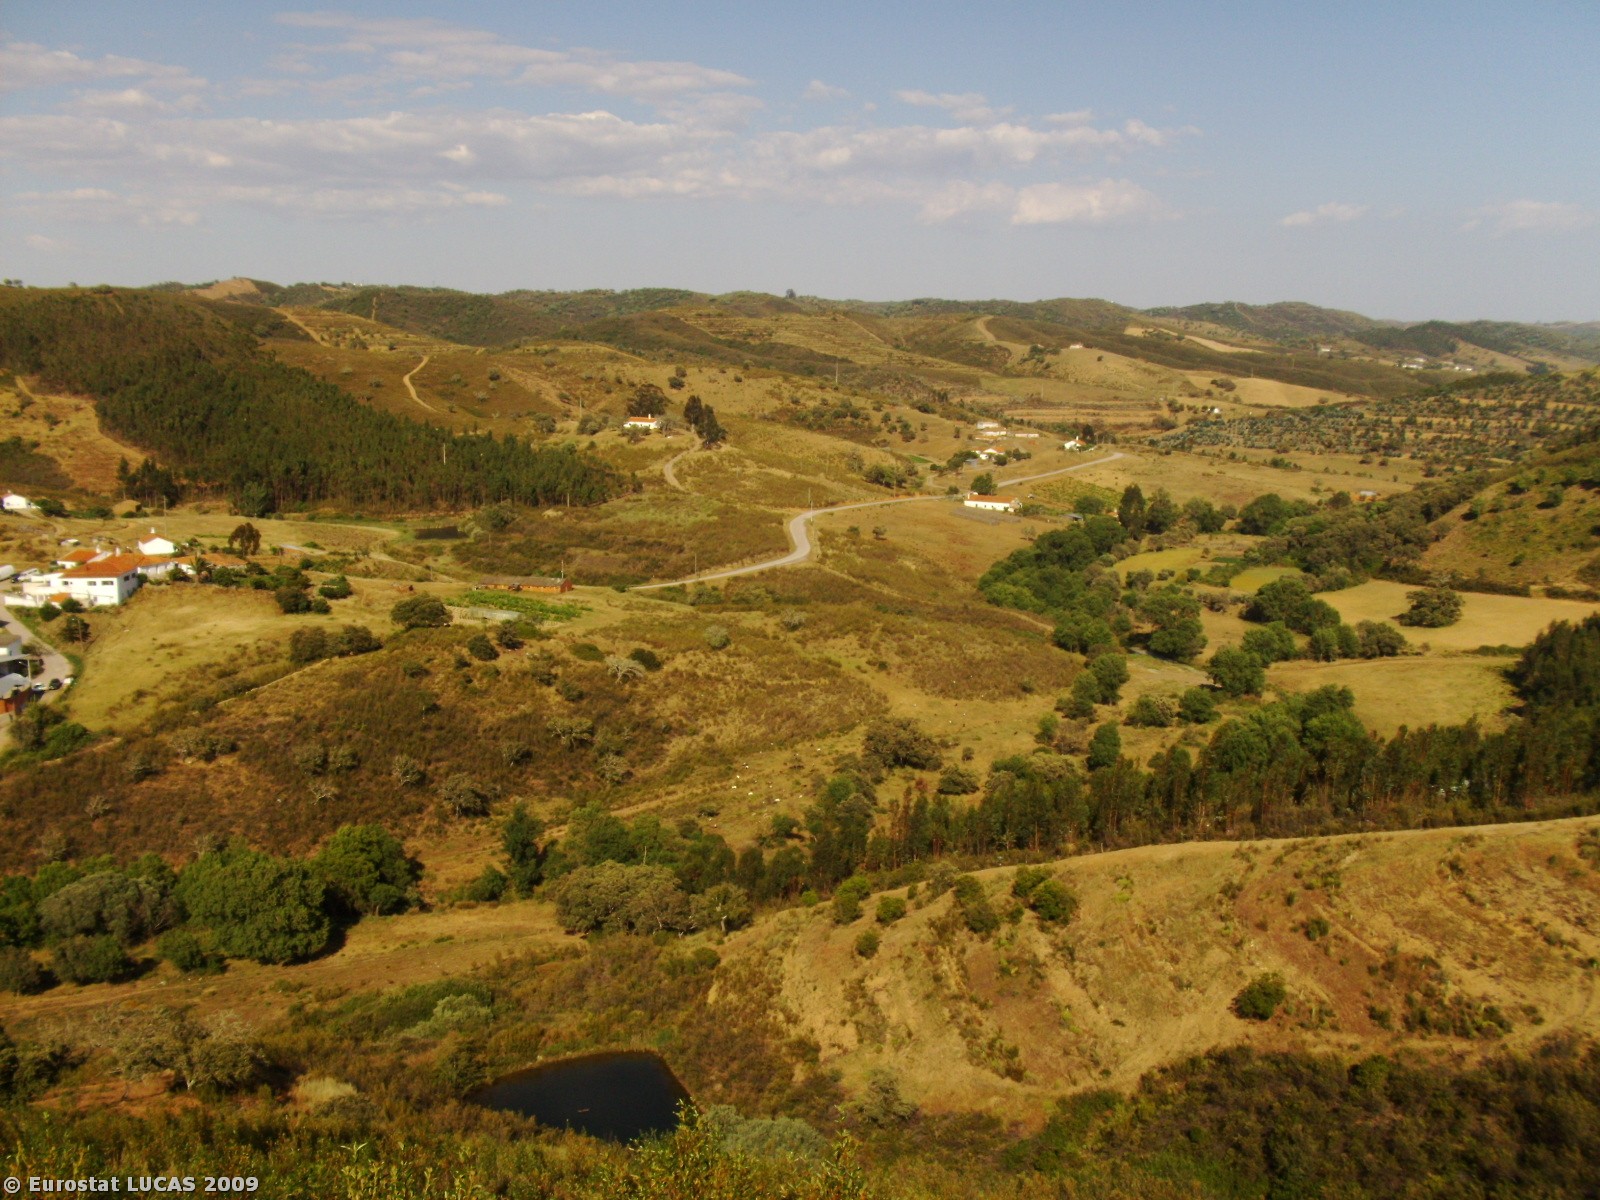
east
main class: Woodland
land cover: Broadleaved woodland
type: broadleaved evergreen forest
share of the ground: 10 - 25 %
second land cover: Shrubland with sparse tree cover
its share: > 75 %
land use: Forestry
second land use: Fallow land
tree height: > 5 m
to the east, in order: Broadleaved woodland; Shrubland with sparse tree cover; Shrubland without tree cover; Fences; Shrubland without tree cover; Fences; Single bushes/trees; Fences; Spontaneously vegetated surfaces; Rivers and streams; Shrubland with sparse tree cover
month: May
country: PT
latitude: 37.4637
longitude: -8.3552
